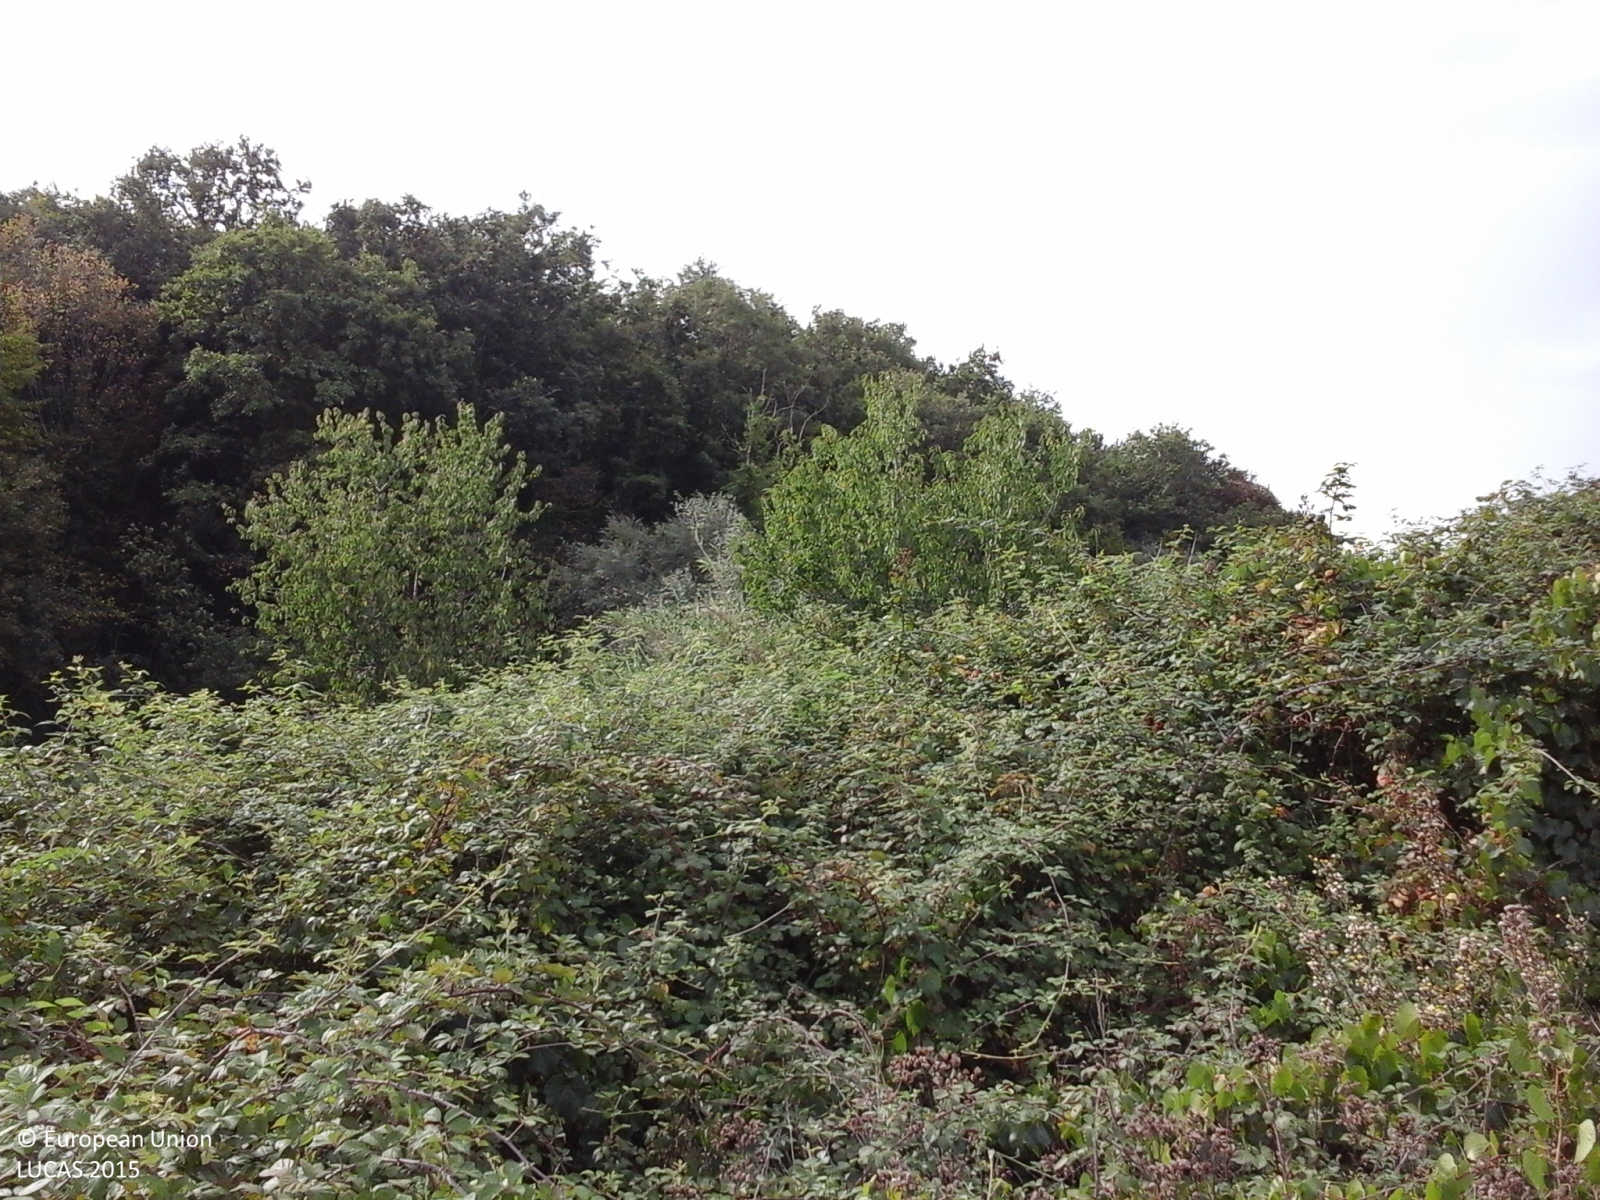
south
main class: Shrubland
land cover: Shrubland without tree cover
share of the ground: > 75 %
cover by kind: shrubs 95 %, herbaceous plants 5 %
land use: Semi-natural and natural areas not in use
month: September
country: IT
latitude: 41.8688
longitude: 15.2009
